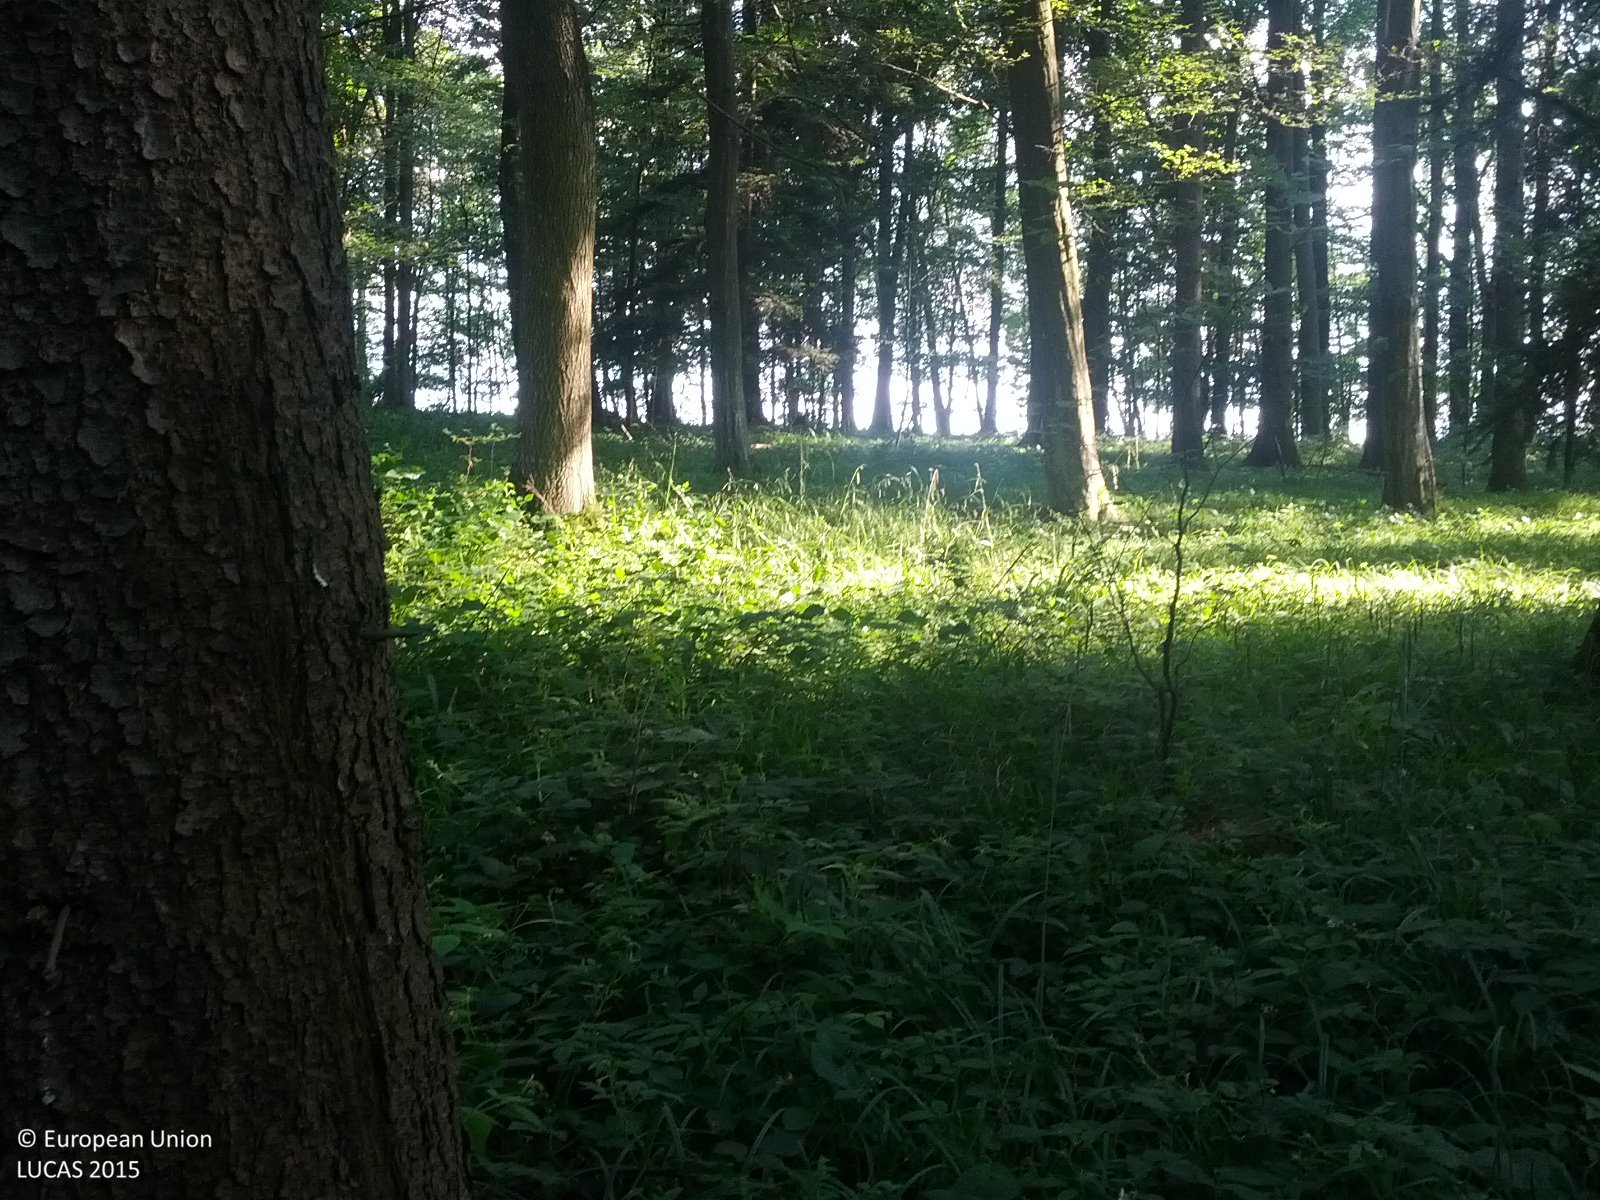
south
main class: Woodland
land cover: Spruce dominated mixed woodland
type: alpine coniferous forest
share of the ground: > 75 %
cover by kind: coniferous forest trees 60 %, broadleaved forest trees 30 %, herbaceous plants 5 %, lichens and mosses 5 %
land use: Forestry
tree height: > 5 m
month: June
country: AT
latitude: 48.1647
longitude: 16.0677
